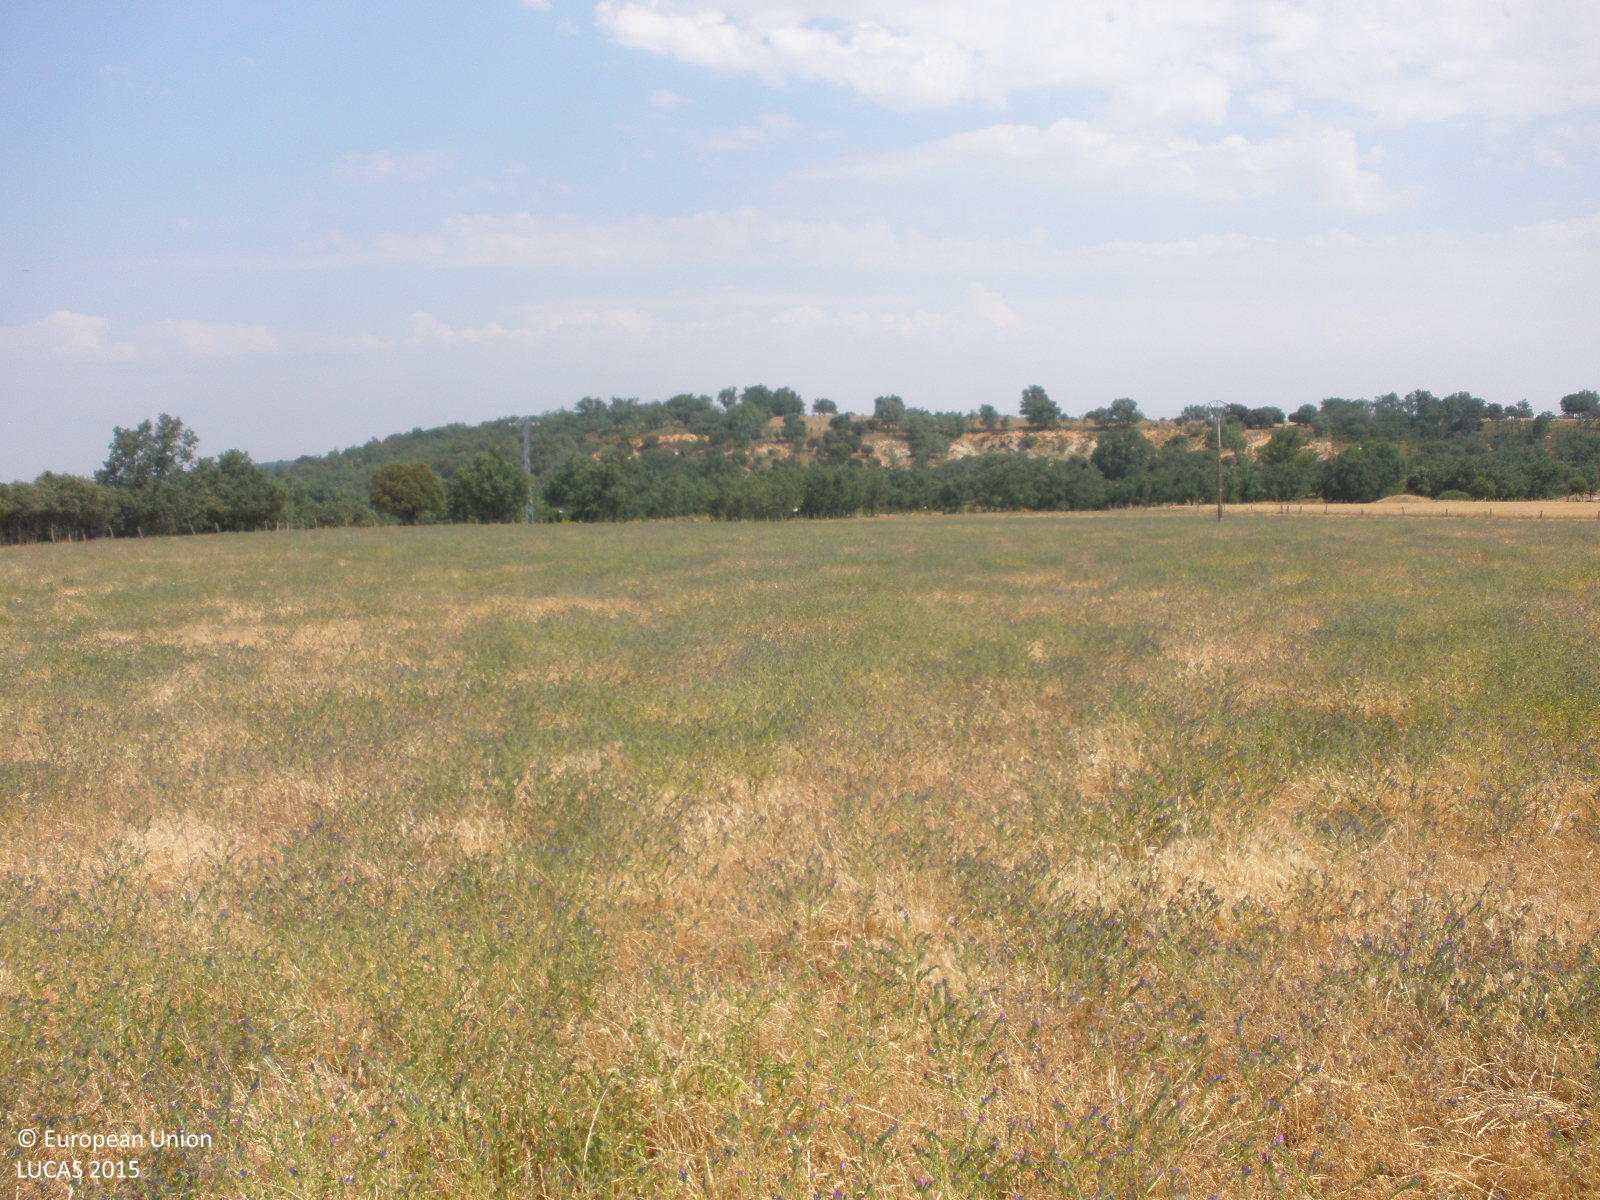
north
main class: Grassland
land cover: Grassland without tree/shrub cover
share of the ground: > 75 %
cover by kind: herbaceous plants 100 %
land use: Agriculture (excluding fallow land and kitchen gardens)
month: June
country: ES
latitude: 40.6314
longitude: -6.3668
